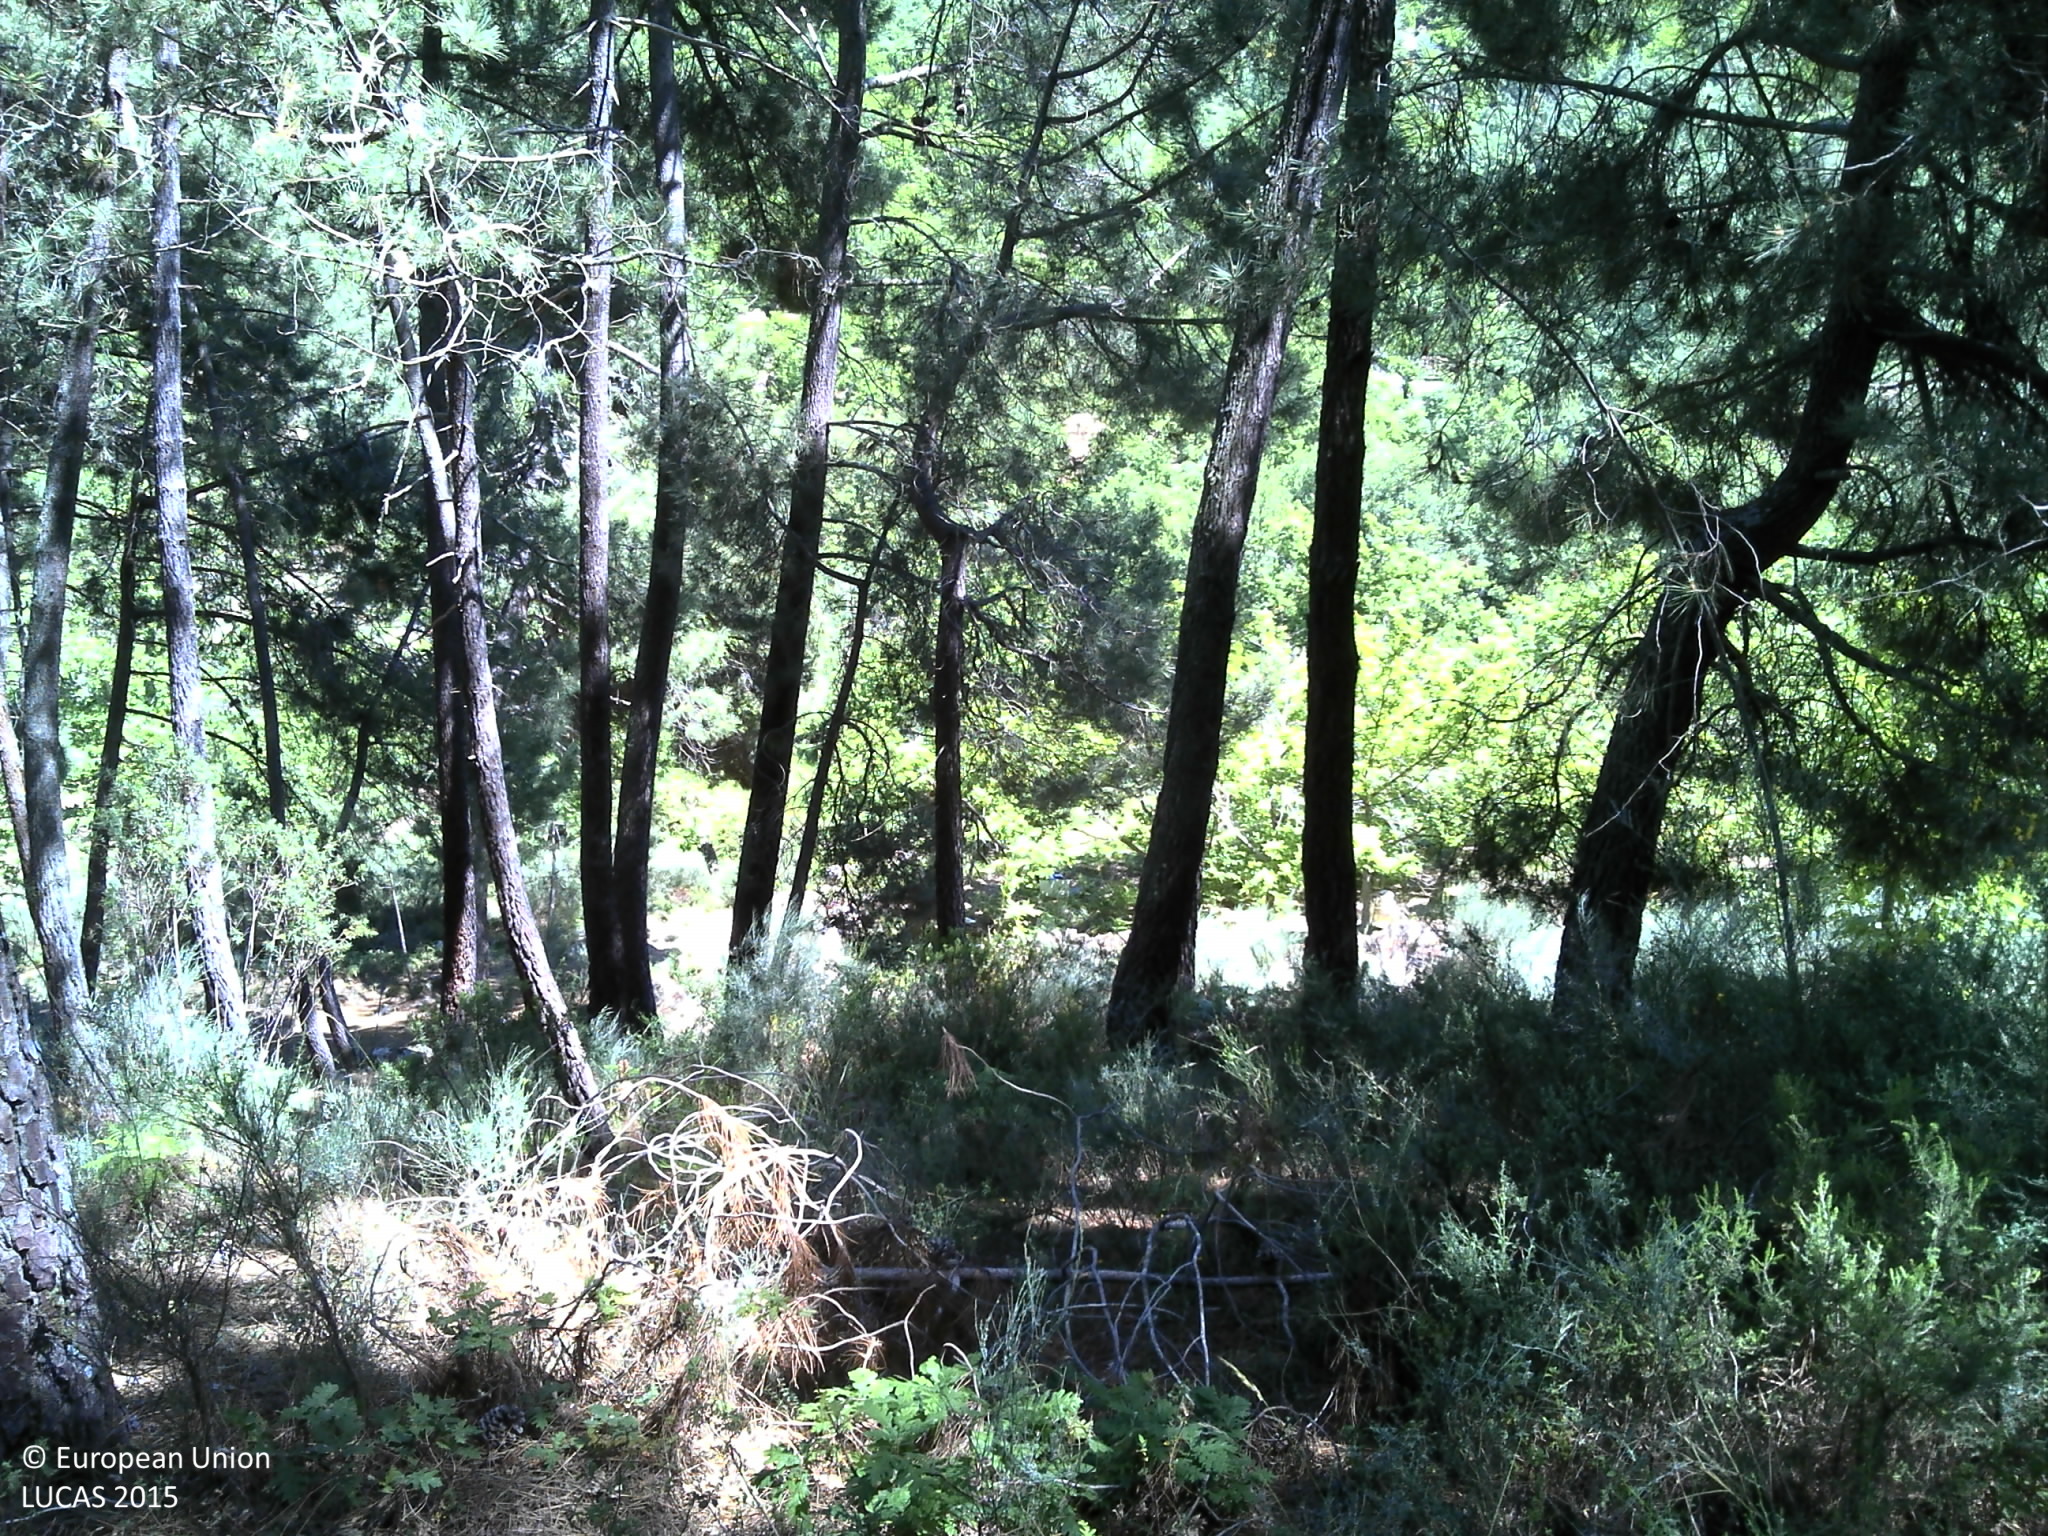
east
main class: Woodland
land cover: Pine dominated coniferous woodland
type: coniferous forest of the mediterranean region
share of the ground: 50 - 75 %
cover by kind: coniferous forest trees 60 %, shrubs 30 %, broadleaved forest trees 5 %, unconsolidated bare surface 5 %
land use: Forestry
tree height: > 5 m
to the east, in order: Pine dominated coniferous woodland; Dry stone walls; Tracks; Dry stone walls; Shruby margins; Nuts trees; Grassland with sparse tree/shrub cover; Abandoned hedges; Grassland without tree/shrub cover; Nuts trees; Dry stone walls; Rivers and streams; Nuts trees; Dry stone walls; Nuts trees; Maize; Potatoes; Fences; Nuts trees; Spontaneously vegetated surfaces; Nuts trees; Fences; Tracks; Dry stone walls; Nuts trees
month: May
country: PT
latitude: 41.5936
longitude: -7.5123
